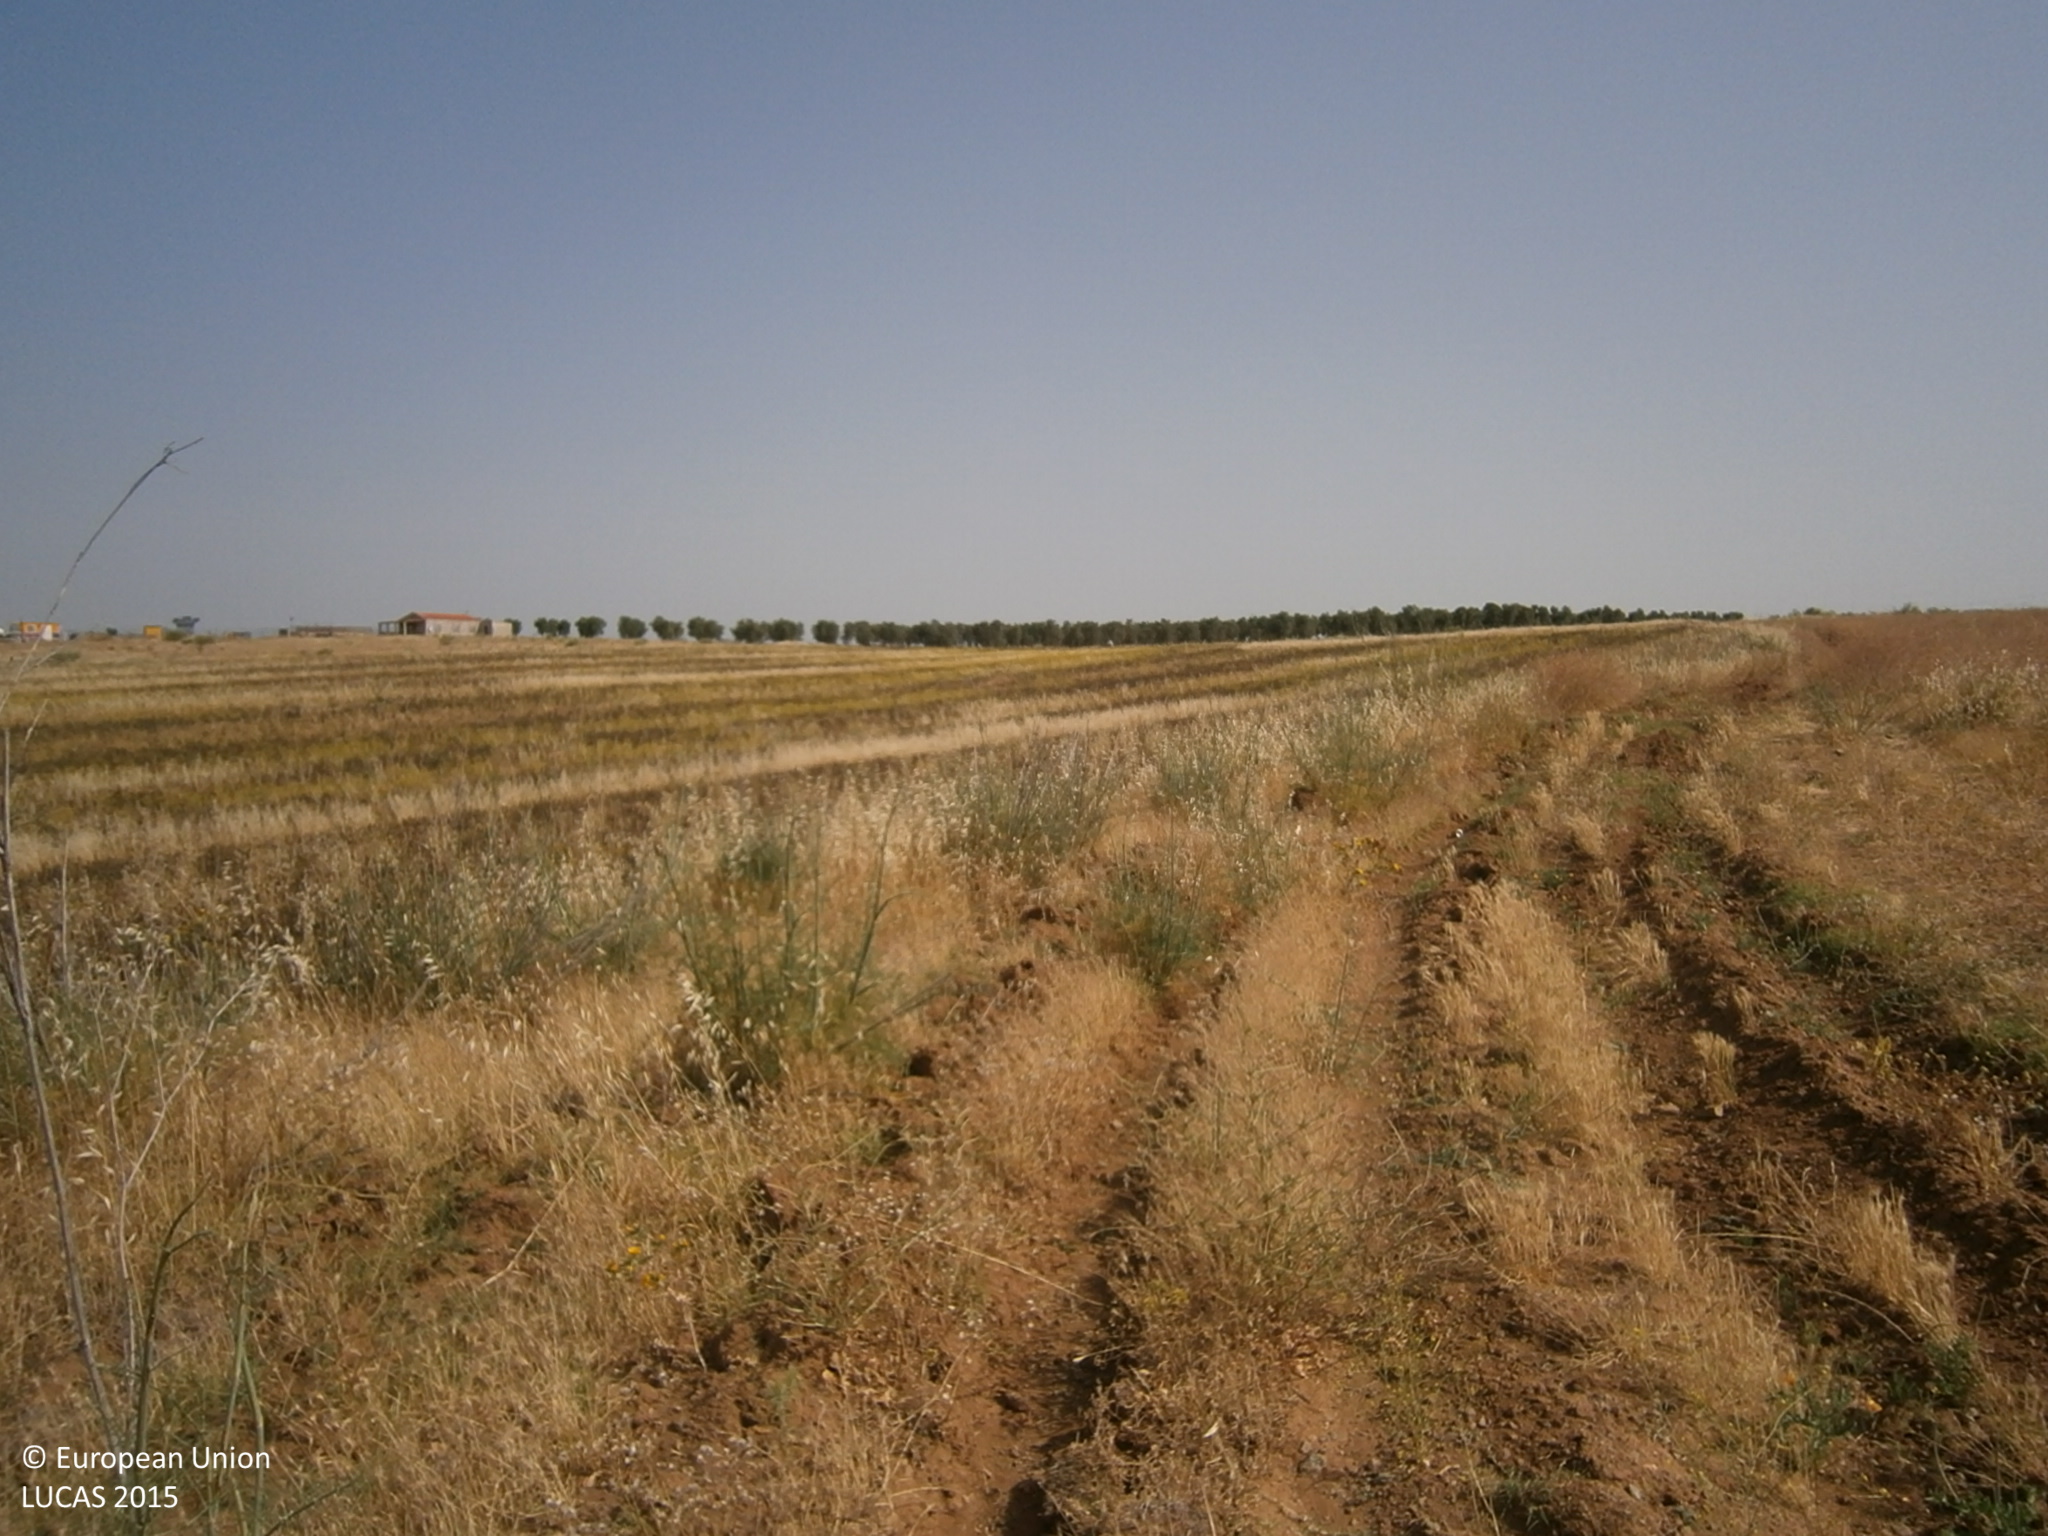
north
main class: Grassland
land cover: Grassland without tree/shrub cover
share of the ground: > 75 %
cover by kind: herbaceous plants 95 %
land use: Agriculture (excluding fallow land and kitchen gardens)
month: June
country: ES
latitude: 38.8936
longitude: -6.3014
